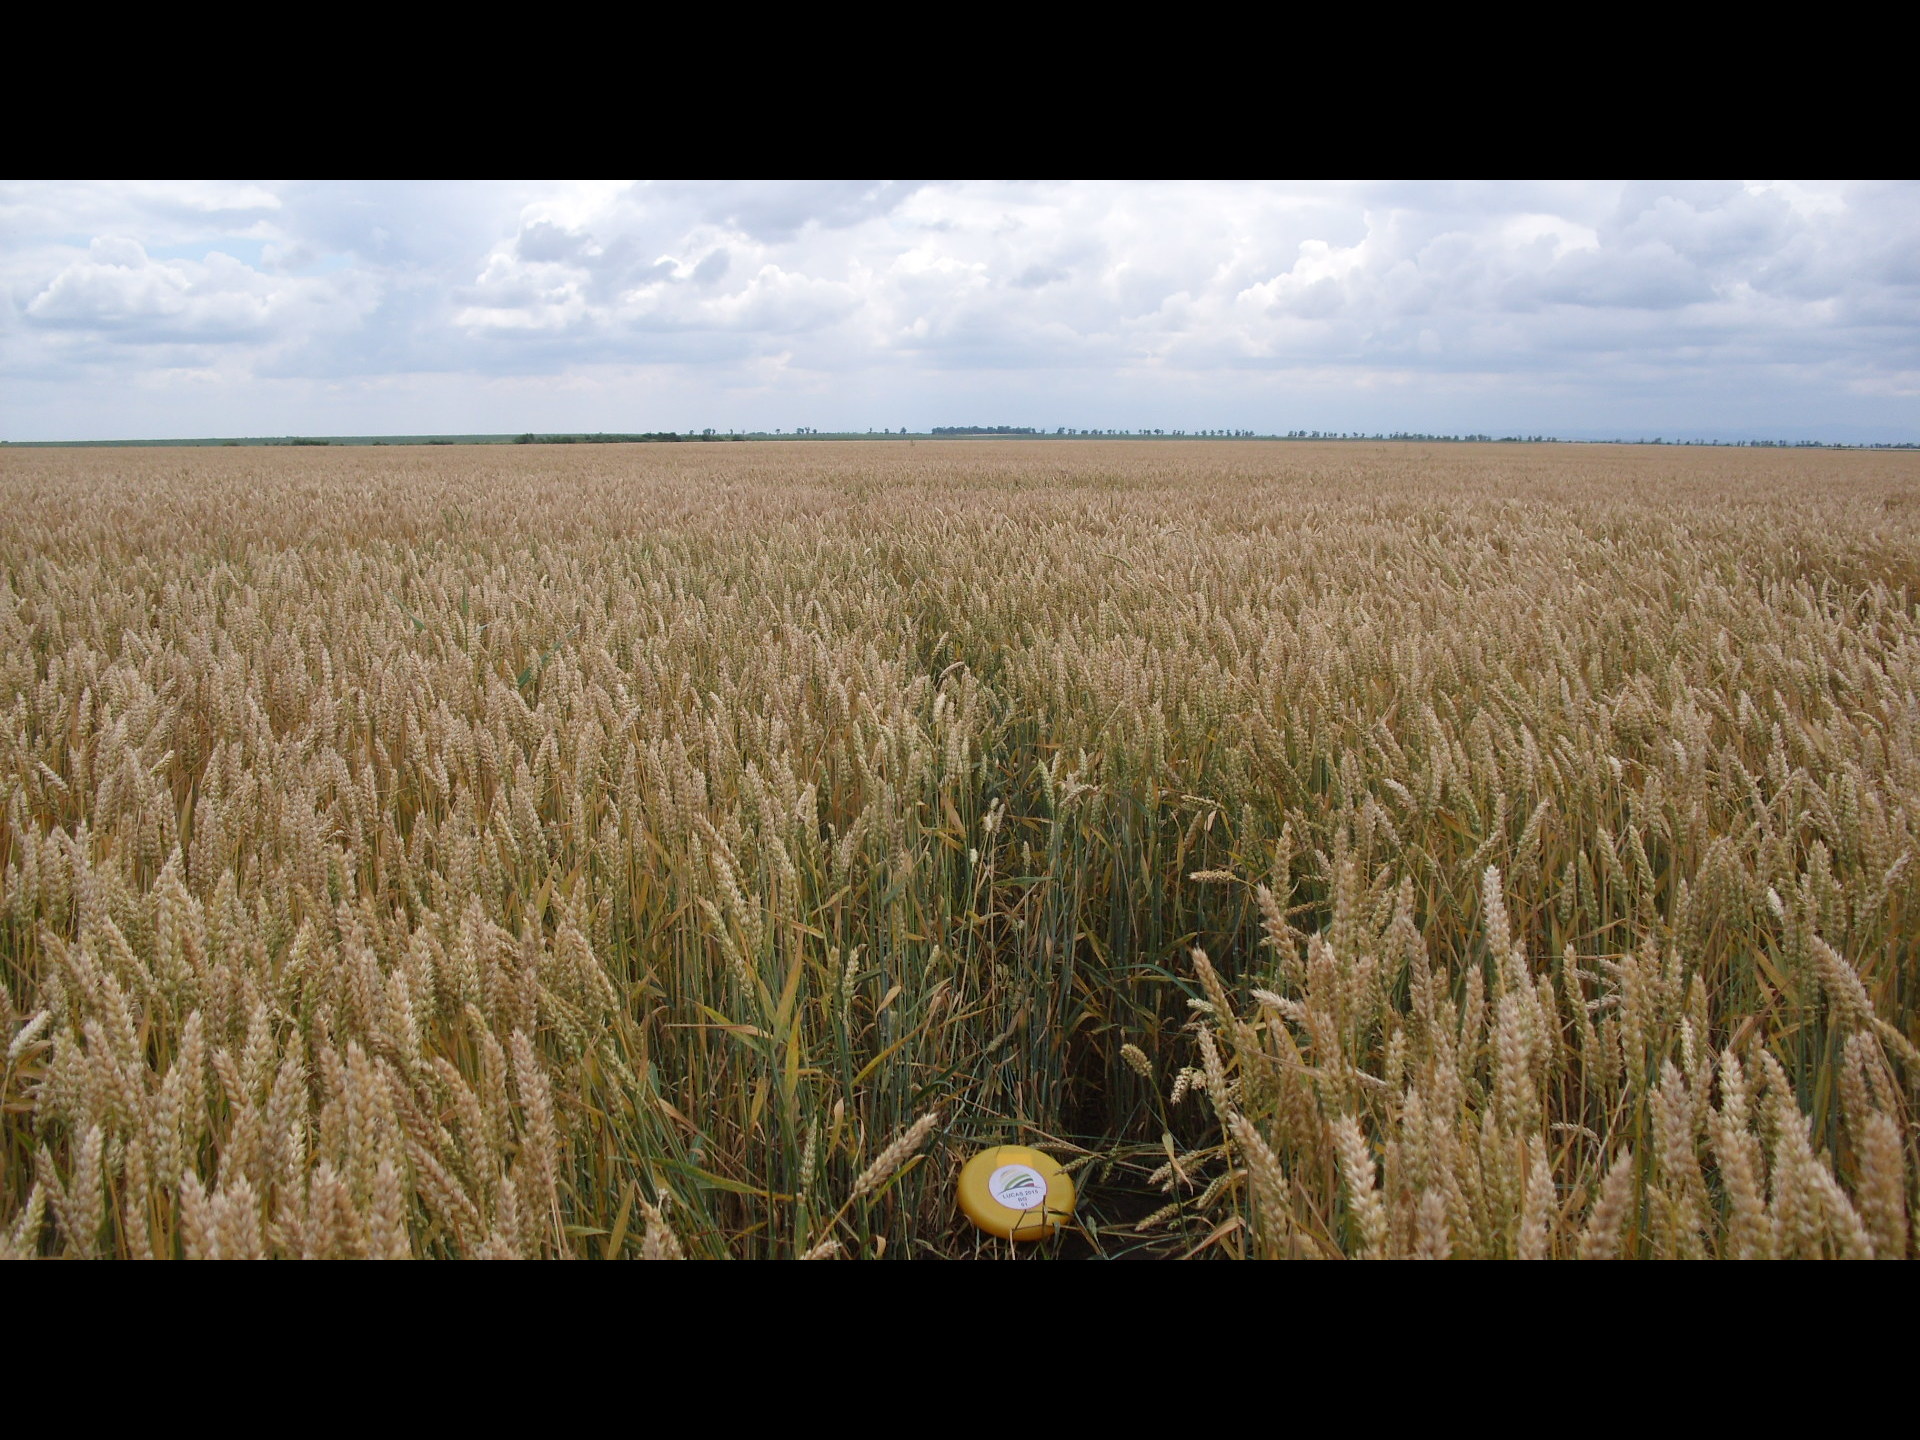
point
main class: Cropland
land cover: Common wheat
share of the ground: > 75 %
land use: Agriculture (excluding fallow land and kitchen gardens)
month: June
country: BG
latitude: 43.6178
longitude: 23.4401
